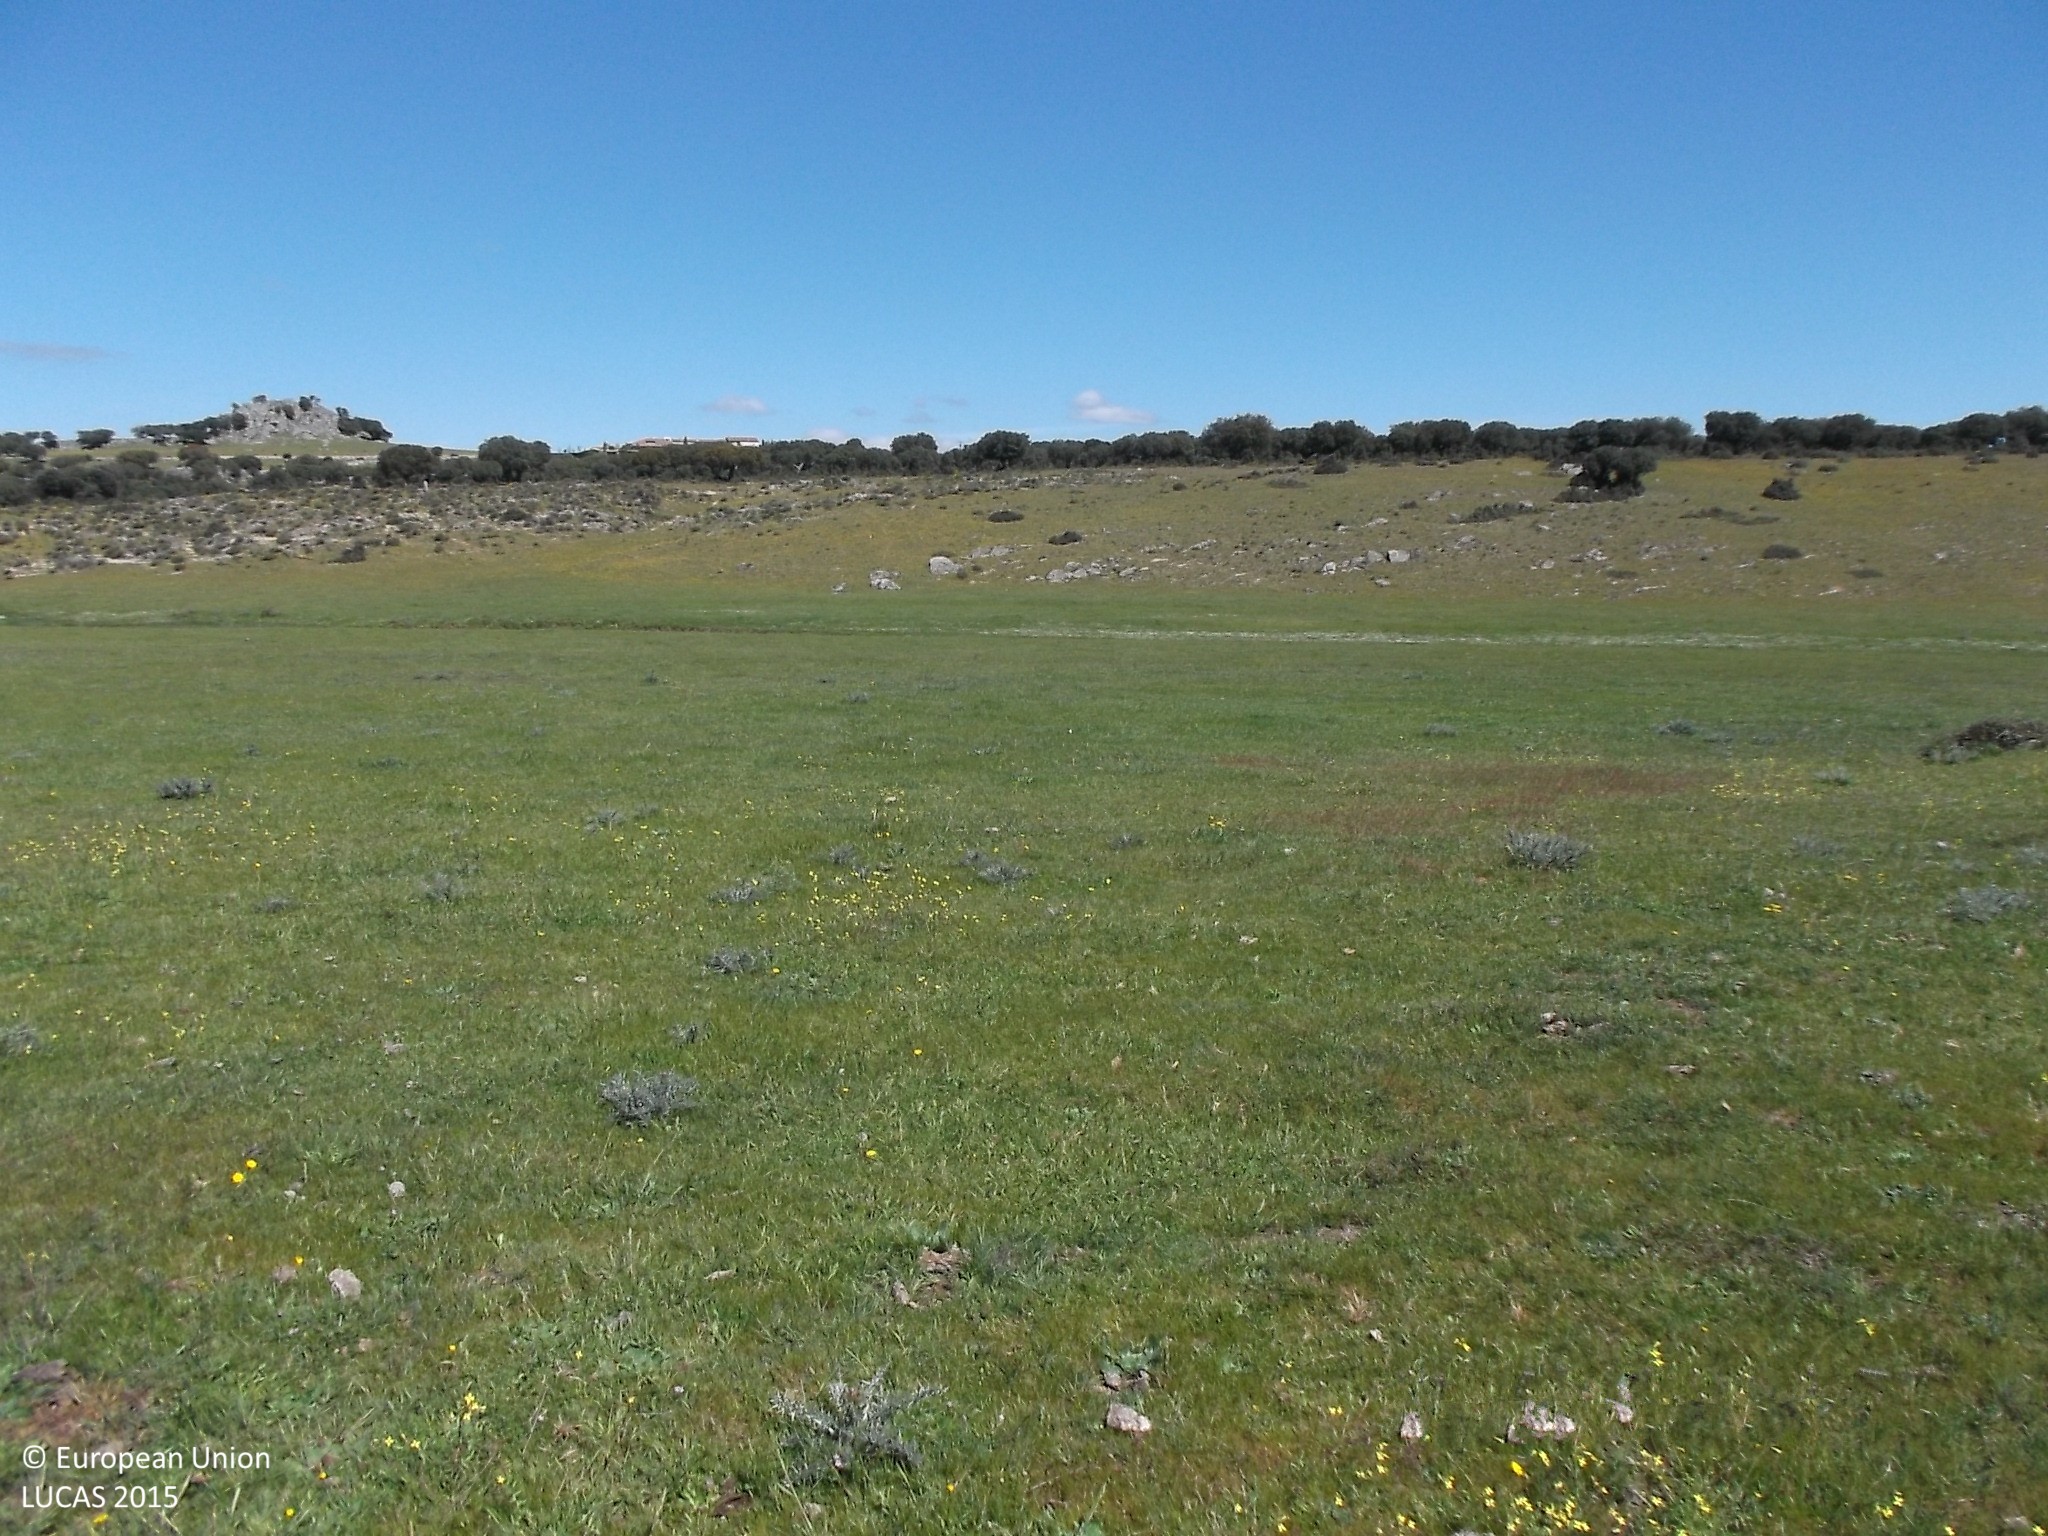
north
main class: Grassland
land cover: Grassland without tree/shrub cover
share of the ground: > 75 %
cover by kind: herbaceous plants 100 %
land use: Agriculture (excluding fallow land and kitchen gardens)
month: April
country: ES
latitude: 41.0508
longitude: -5.9436
